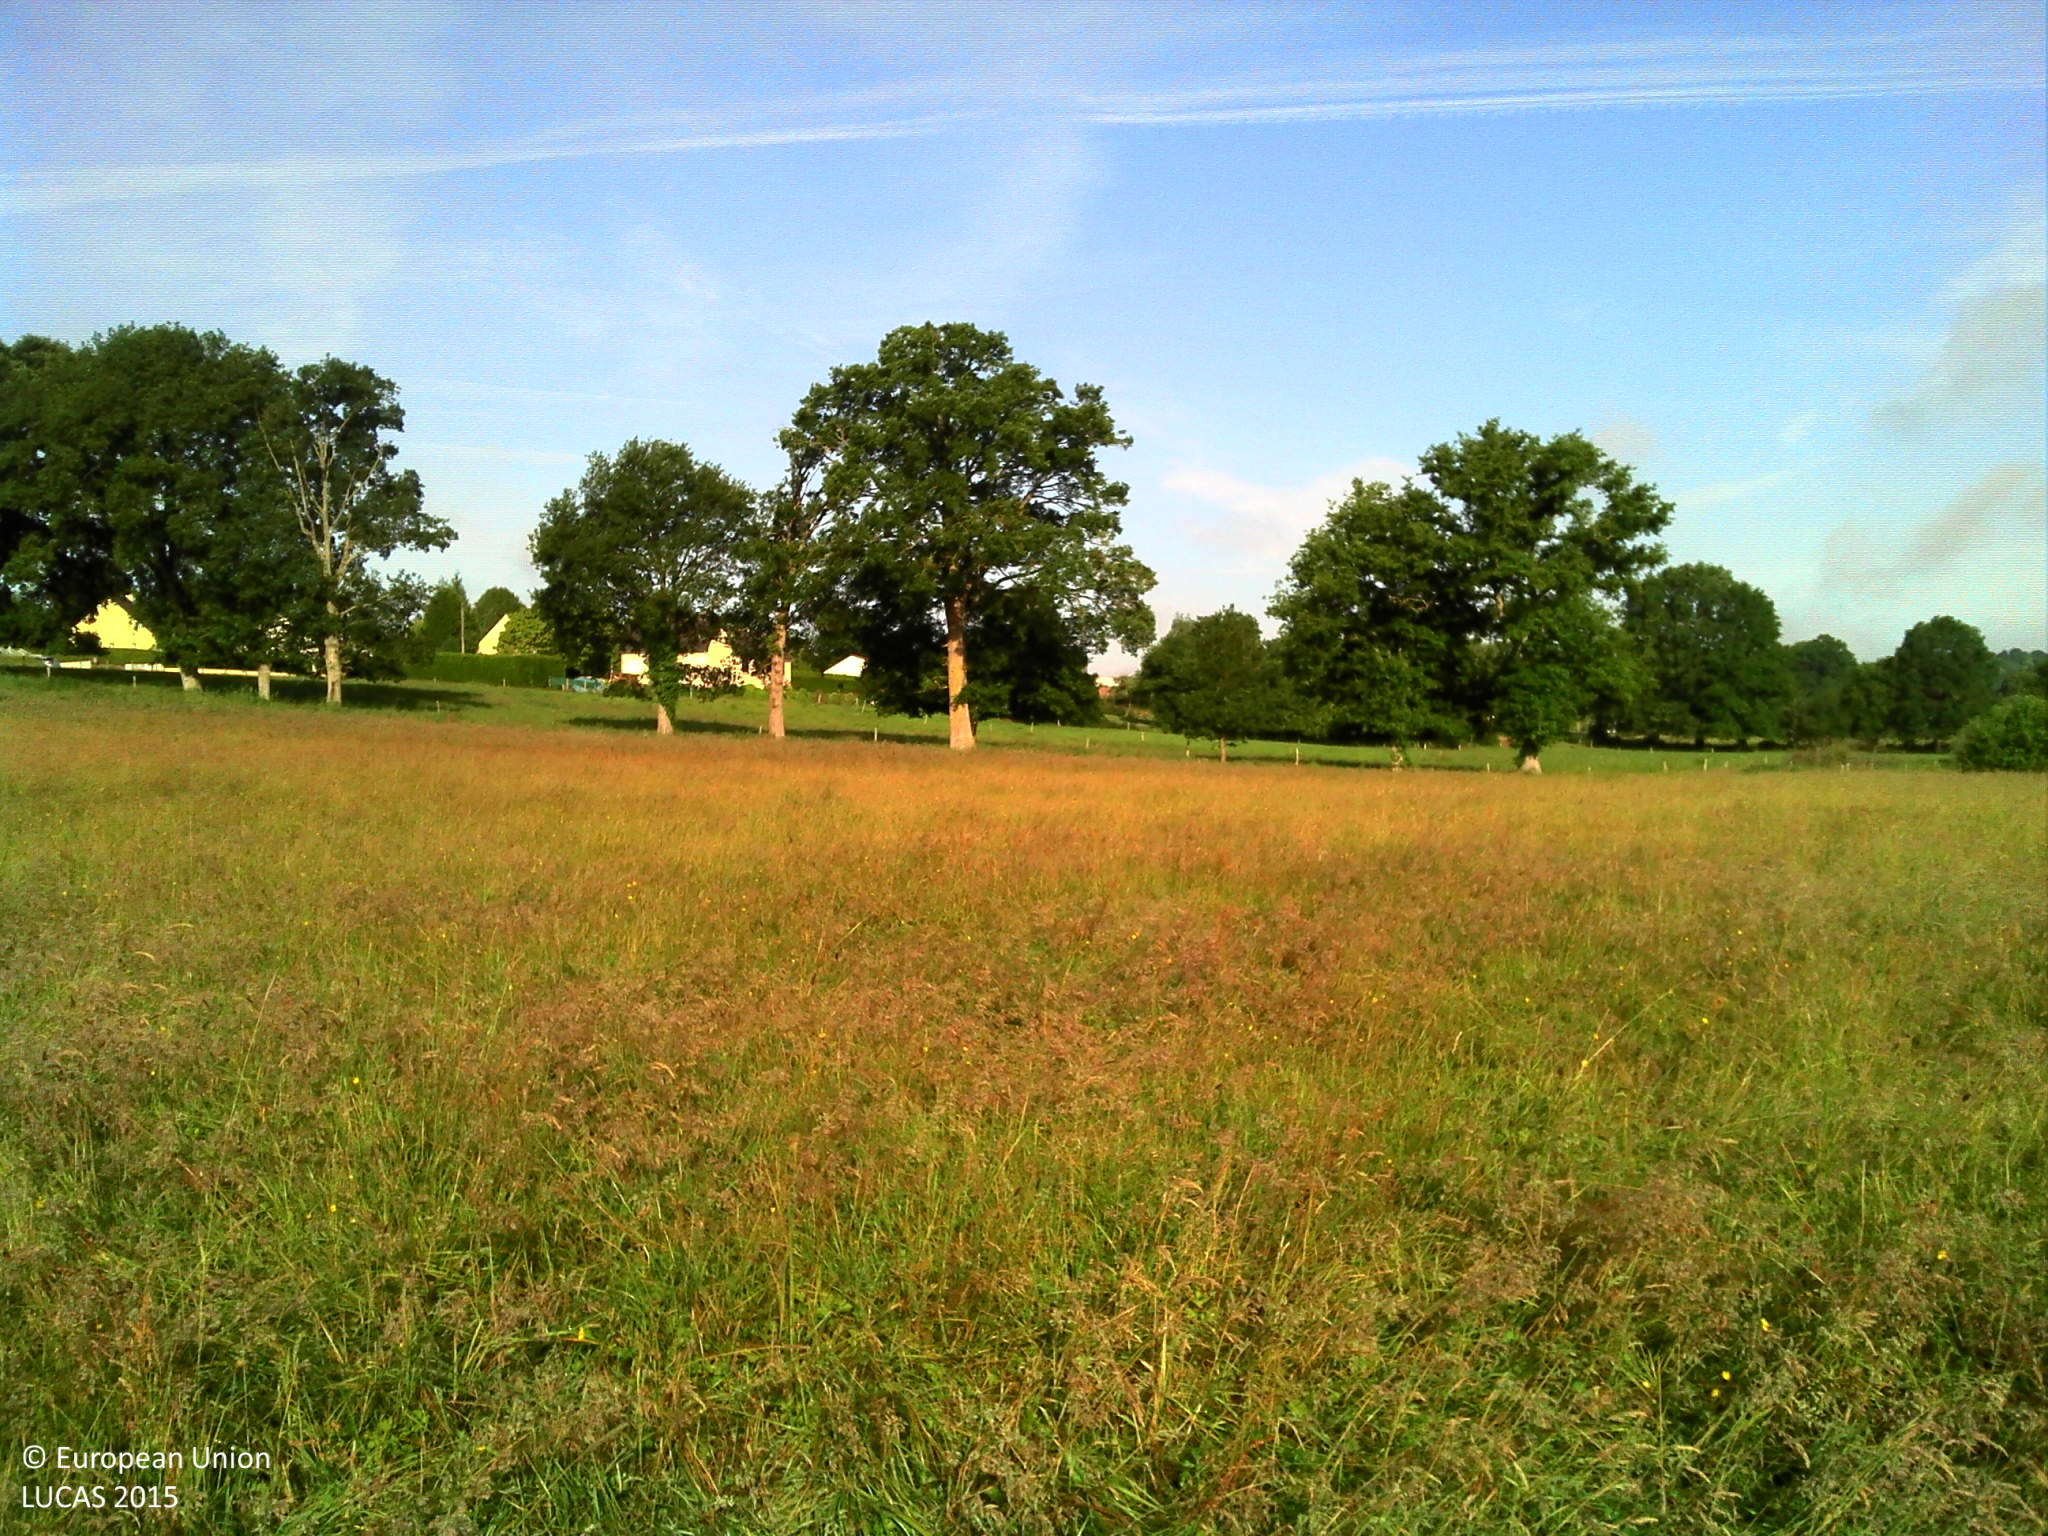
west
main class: Grassland
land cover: Grassland without tree/shrub cover
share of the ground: > 75 %
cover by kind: herbaceous plants 100 %
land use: Agriculture (excluding fallow land and kitchen gardens)
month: June
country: FR
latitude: 48.2547
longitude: -1.5083
